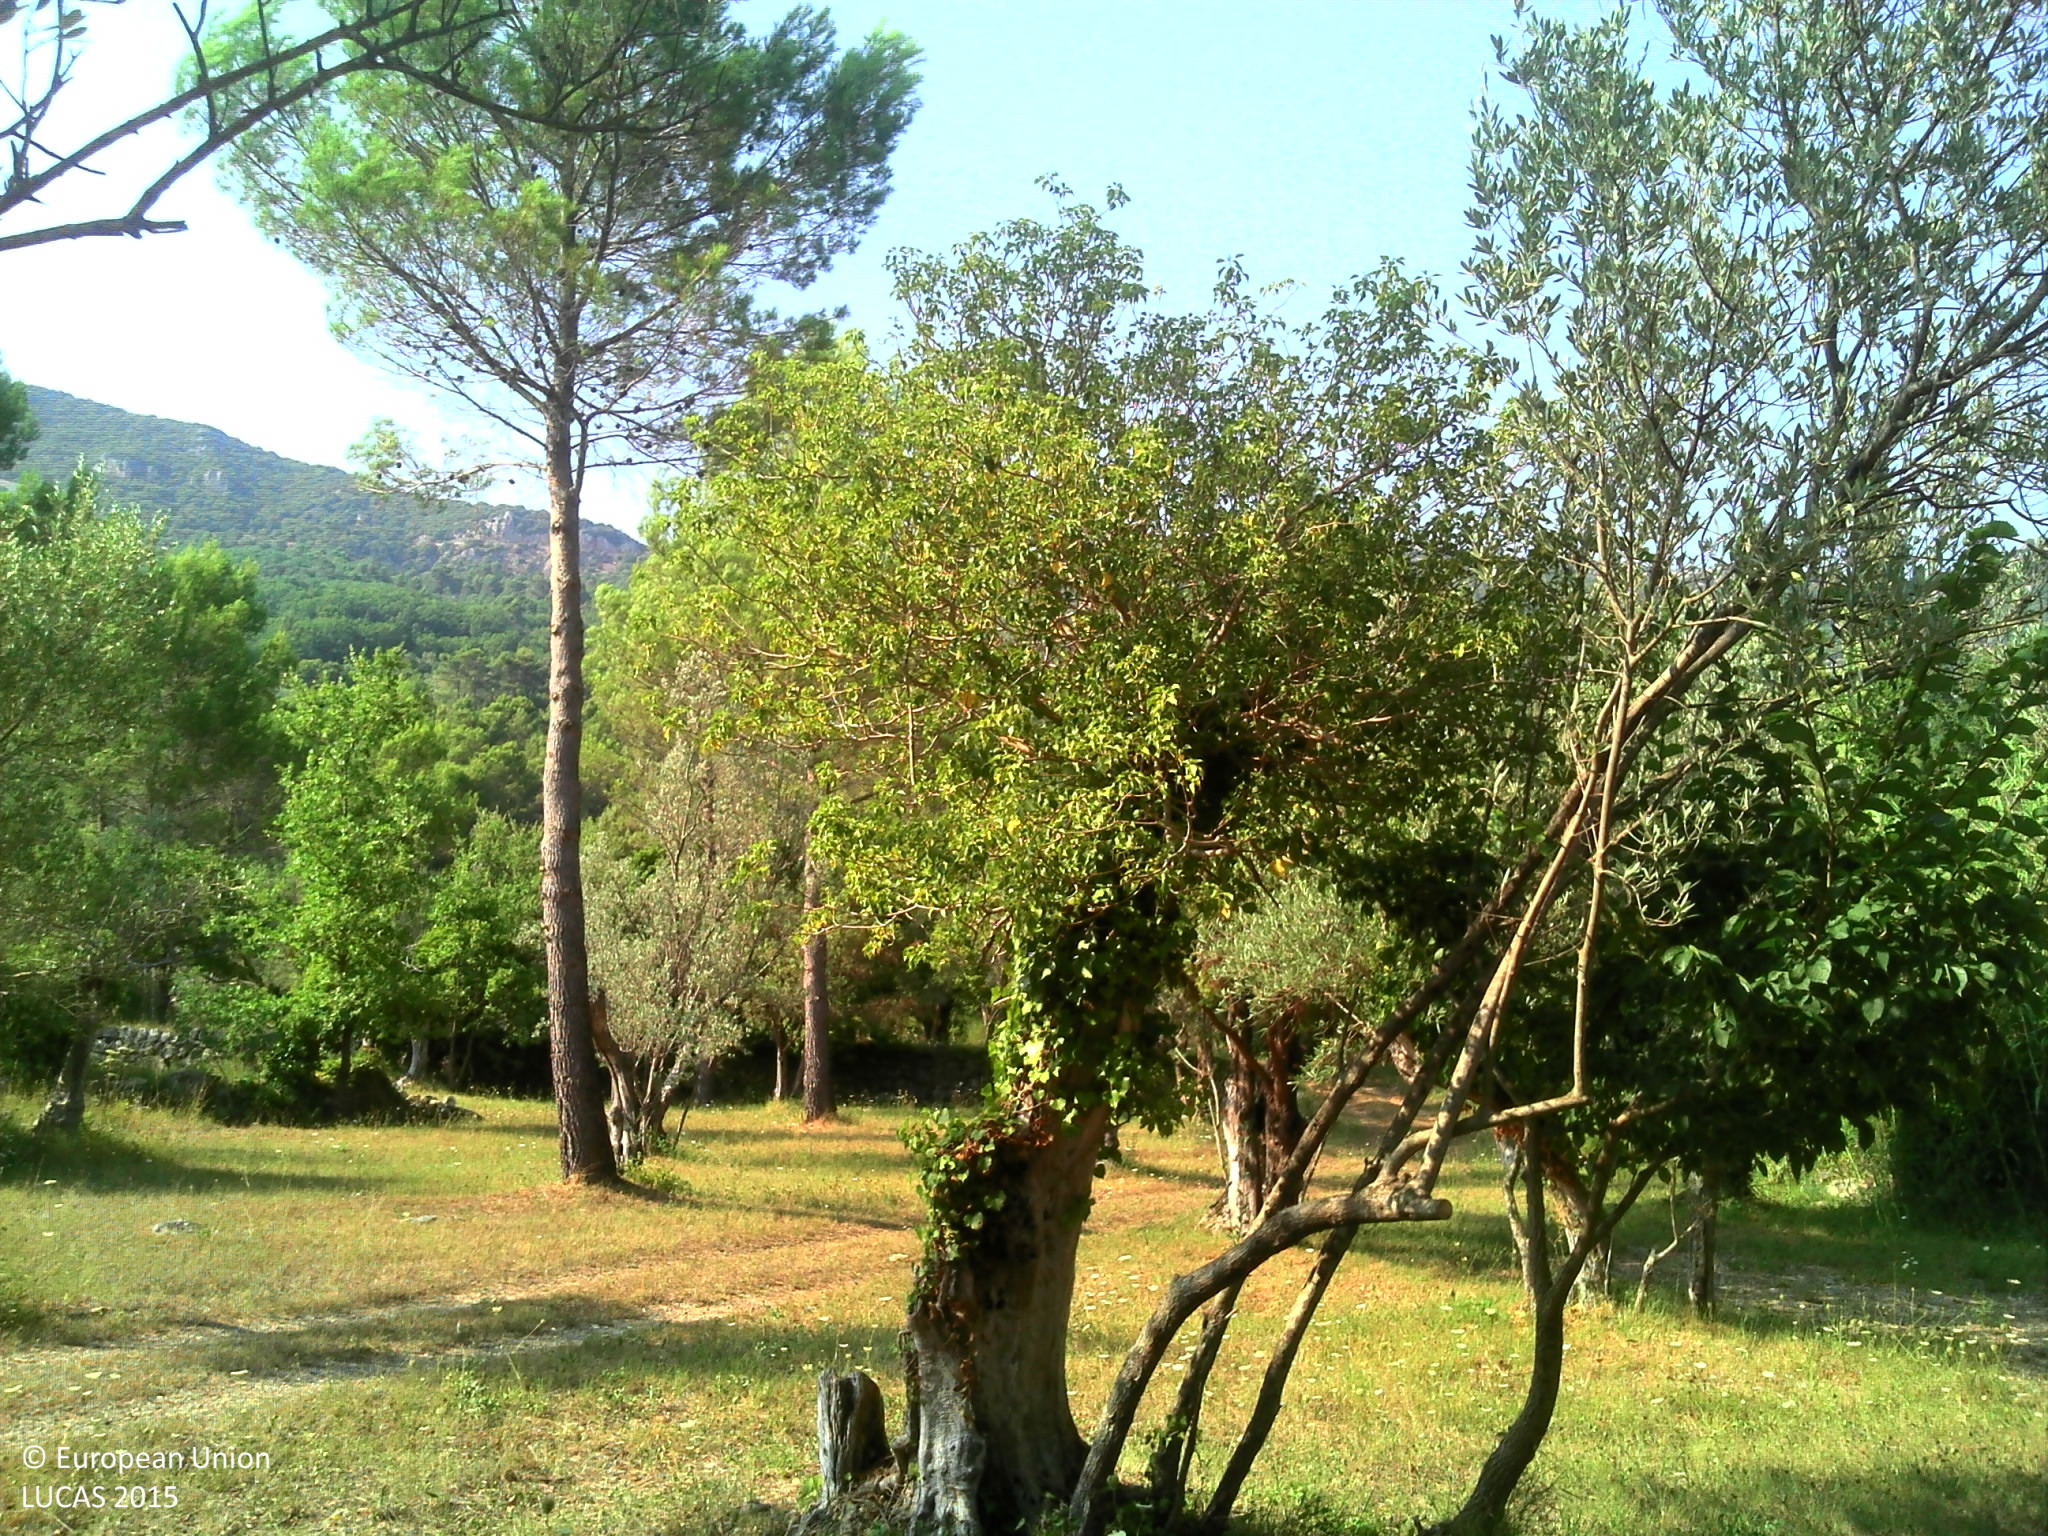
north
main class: Woodland
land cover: Broadleaved woodland
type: thermophilous deciduous forest
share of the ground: > 75 %
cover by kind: broadleaved forest trees 80 %, shrubs 15 %, coniferous forest trees 5 %
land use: Residential
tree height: > 5 m
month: August
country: FR
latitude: 43.6260
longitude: 6.5751
